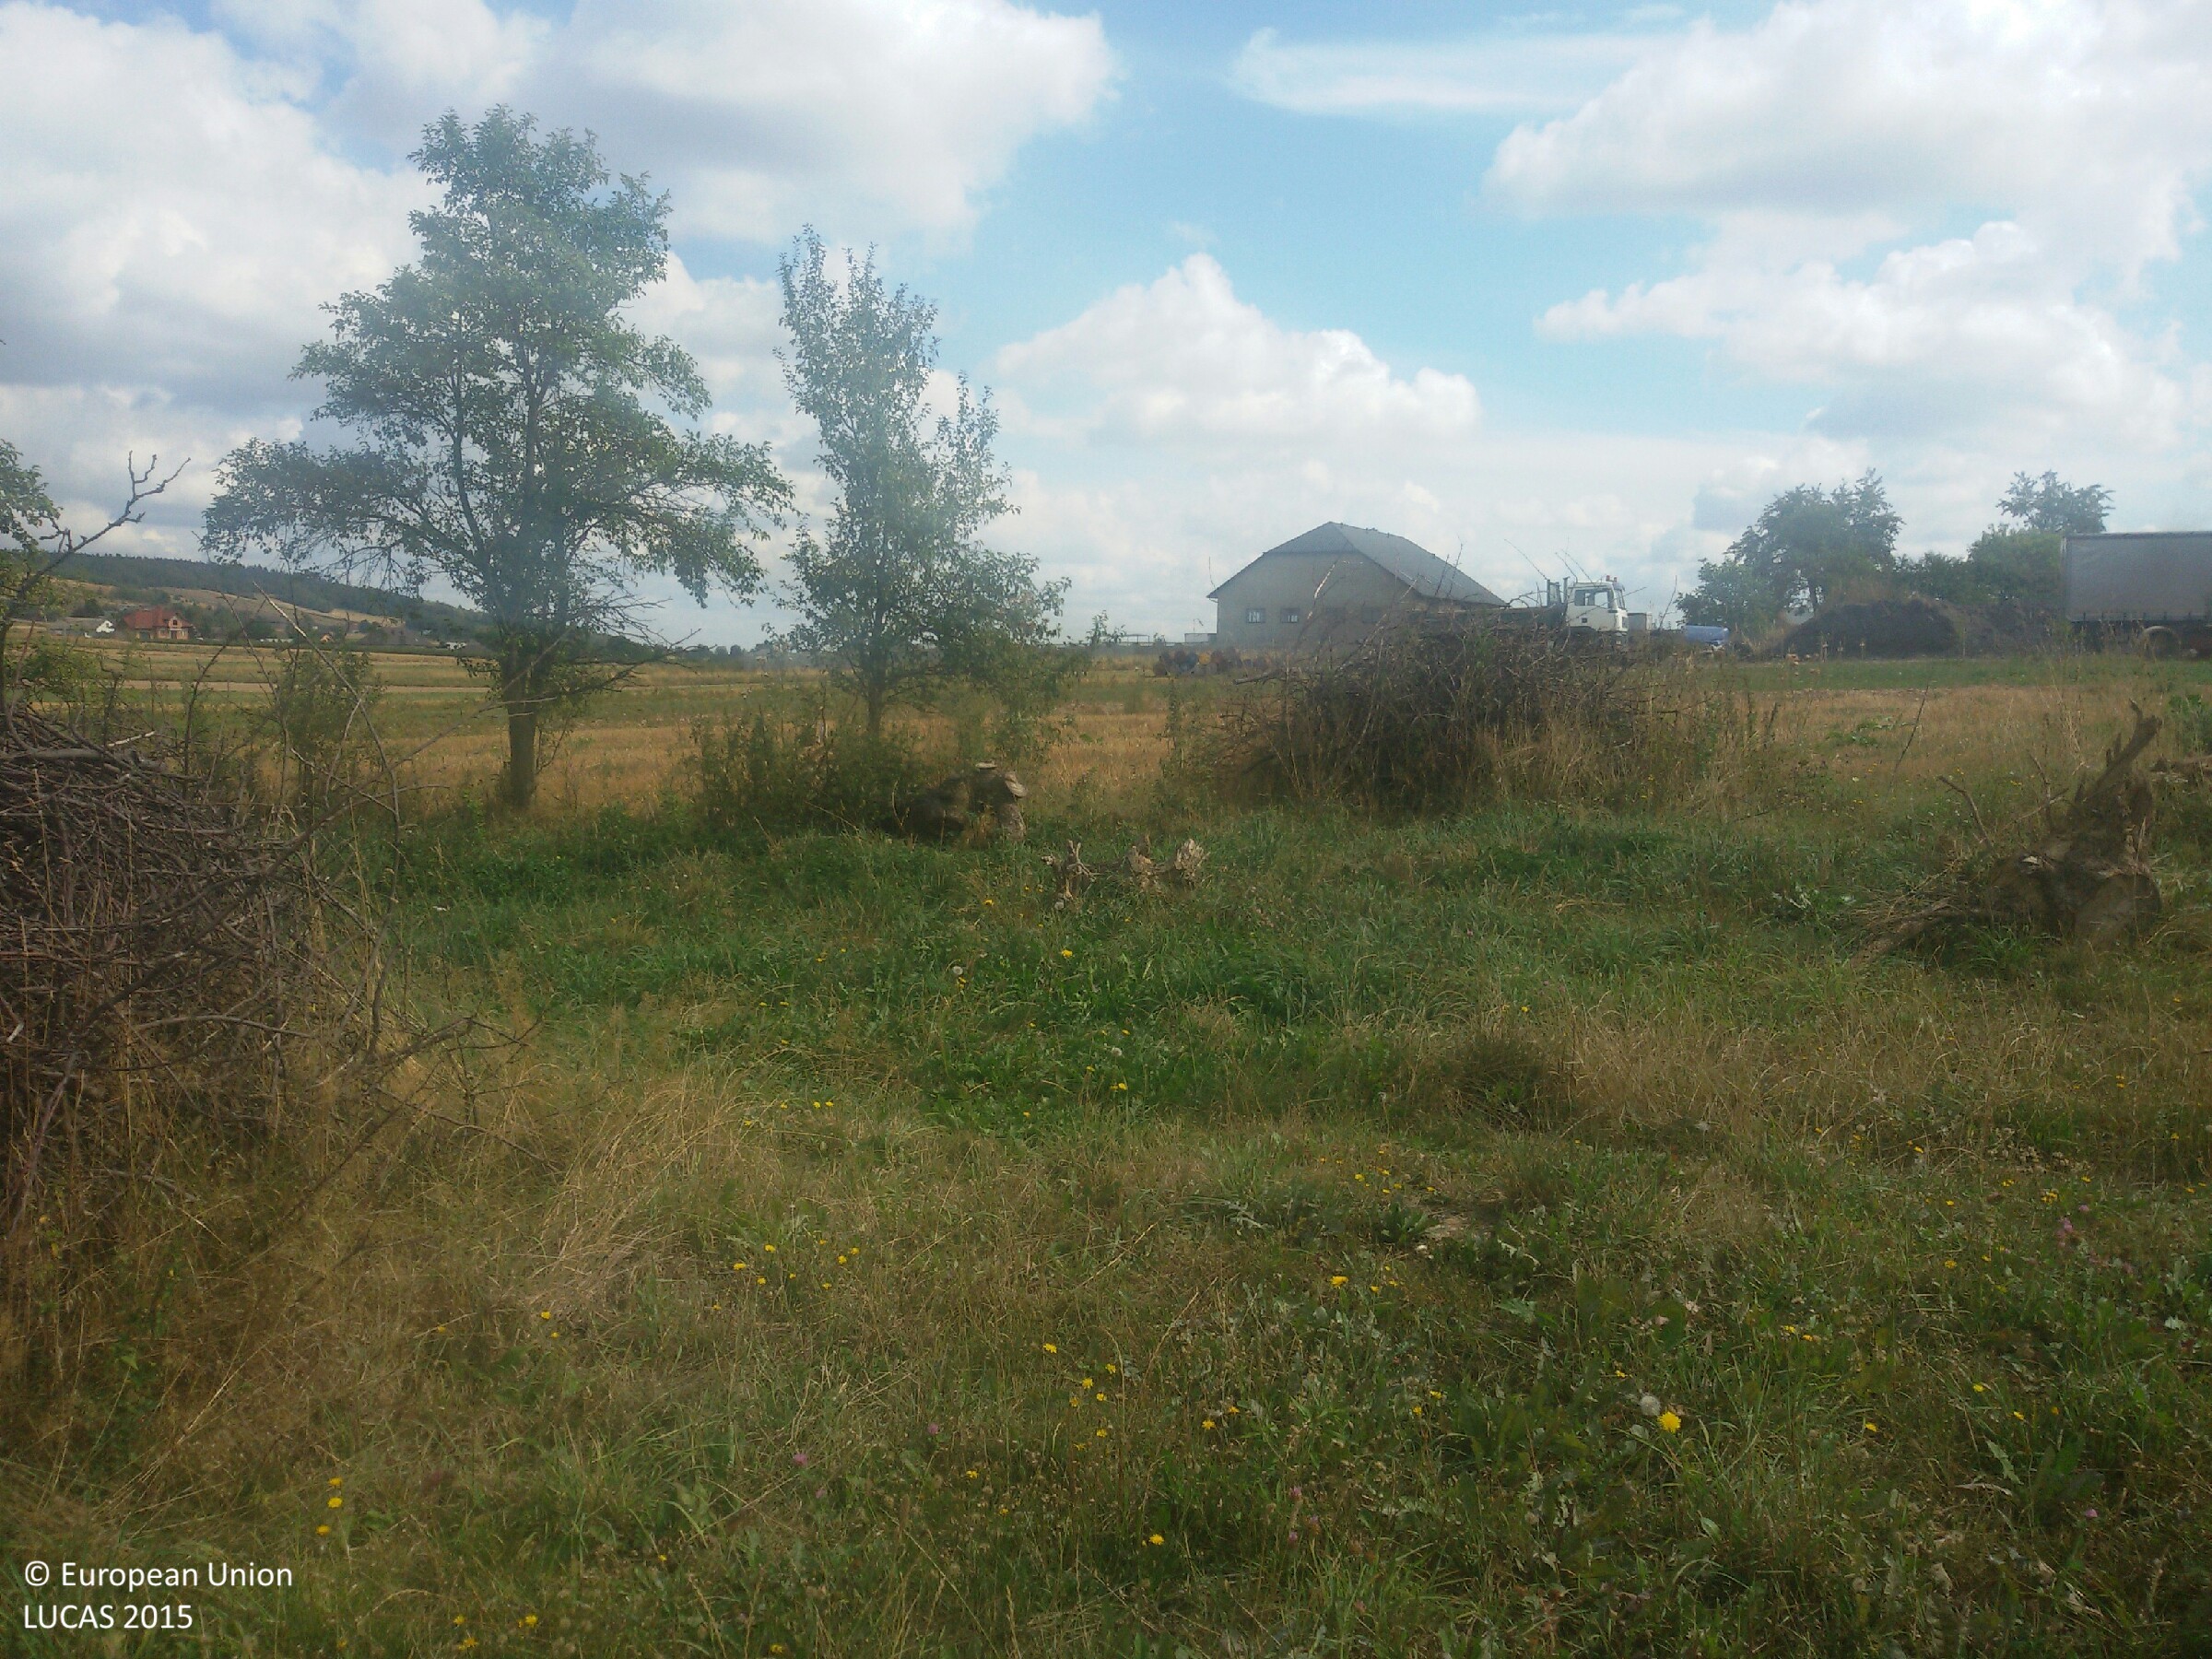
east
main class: Grassland
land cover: Grassland without tree/shrub cover
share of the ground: > 75 %
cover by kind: herbaceous plants 100 %
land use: Agriculture (excluding fallow land and kitchen gardens)
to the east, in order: Grassland without tree/shrub cover; Single bushes/trees; Grassland without tree/shrub cover; Common wheat; Grass margins; Potatoes; Grassland without tree/shrub cover; Potatoes; Oats; Grassland without tree/shrub cover; Rye; Spontaneously vegetated surfaces; Grassland without tree/shrub cover; Artificial constructions in urban areas; Grassland without tree/shrub cover; Common wheat
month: September
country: PL
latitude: 50.9632
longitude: 20.9359
